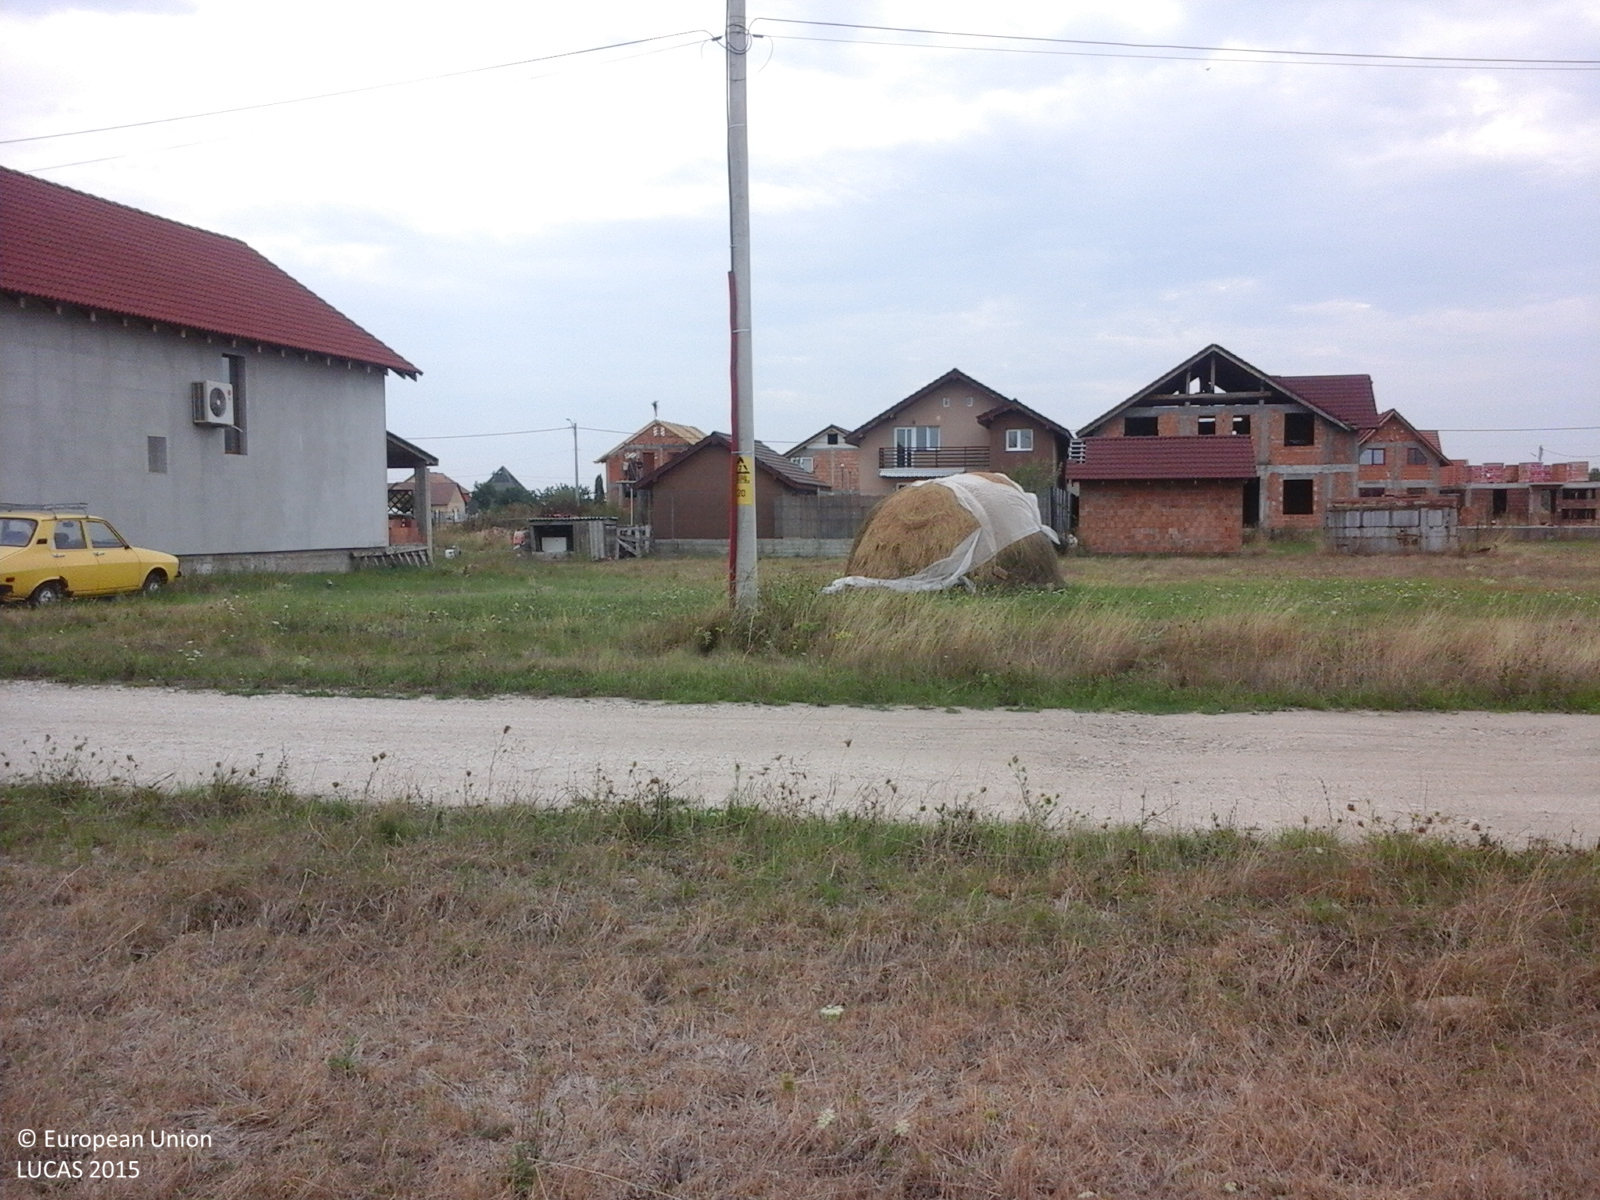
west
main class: Grassland
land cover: Grassland without tree/shrub cover
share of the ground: > 75 %
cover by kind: herbaceous plants 100 %
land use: Residential
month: August
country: RO
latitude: 46.2503
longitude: 21.3847
